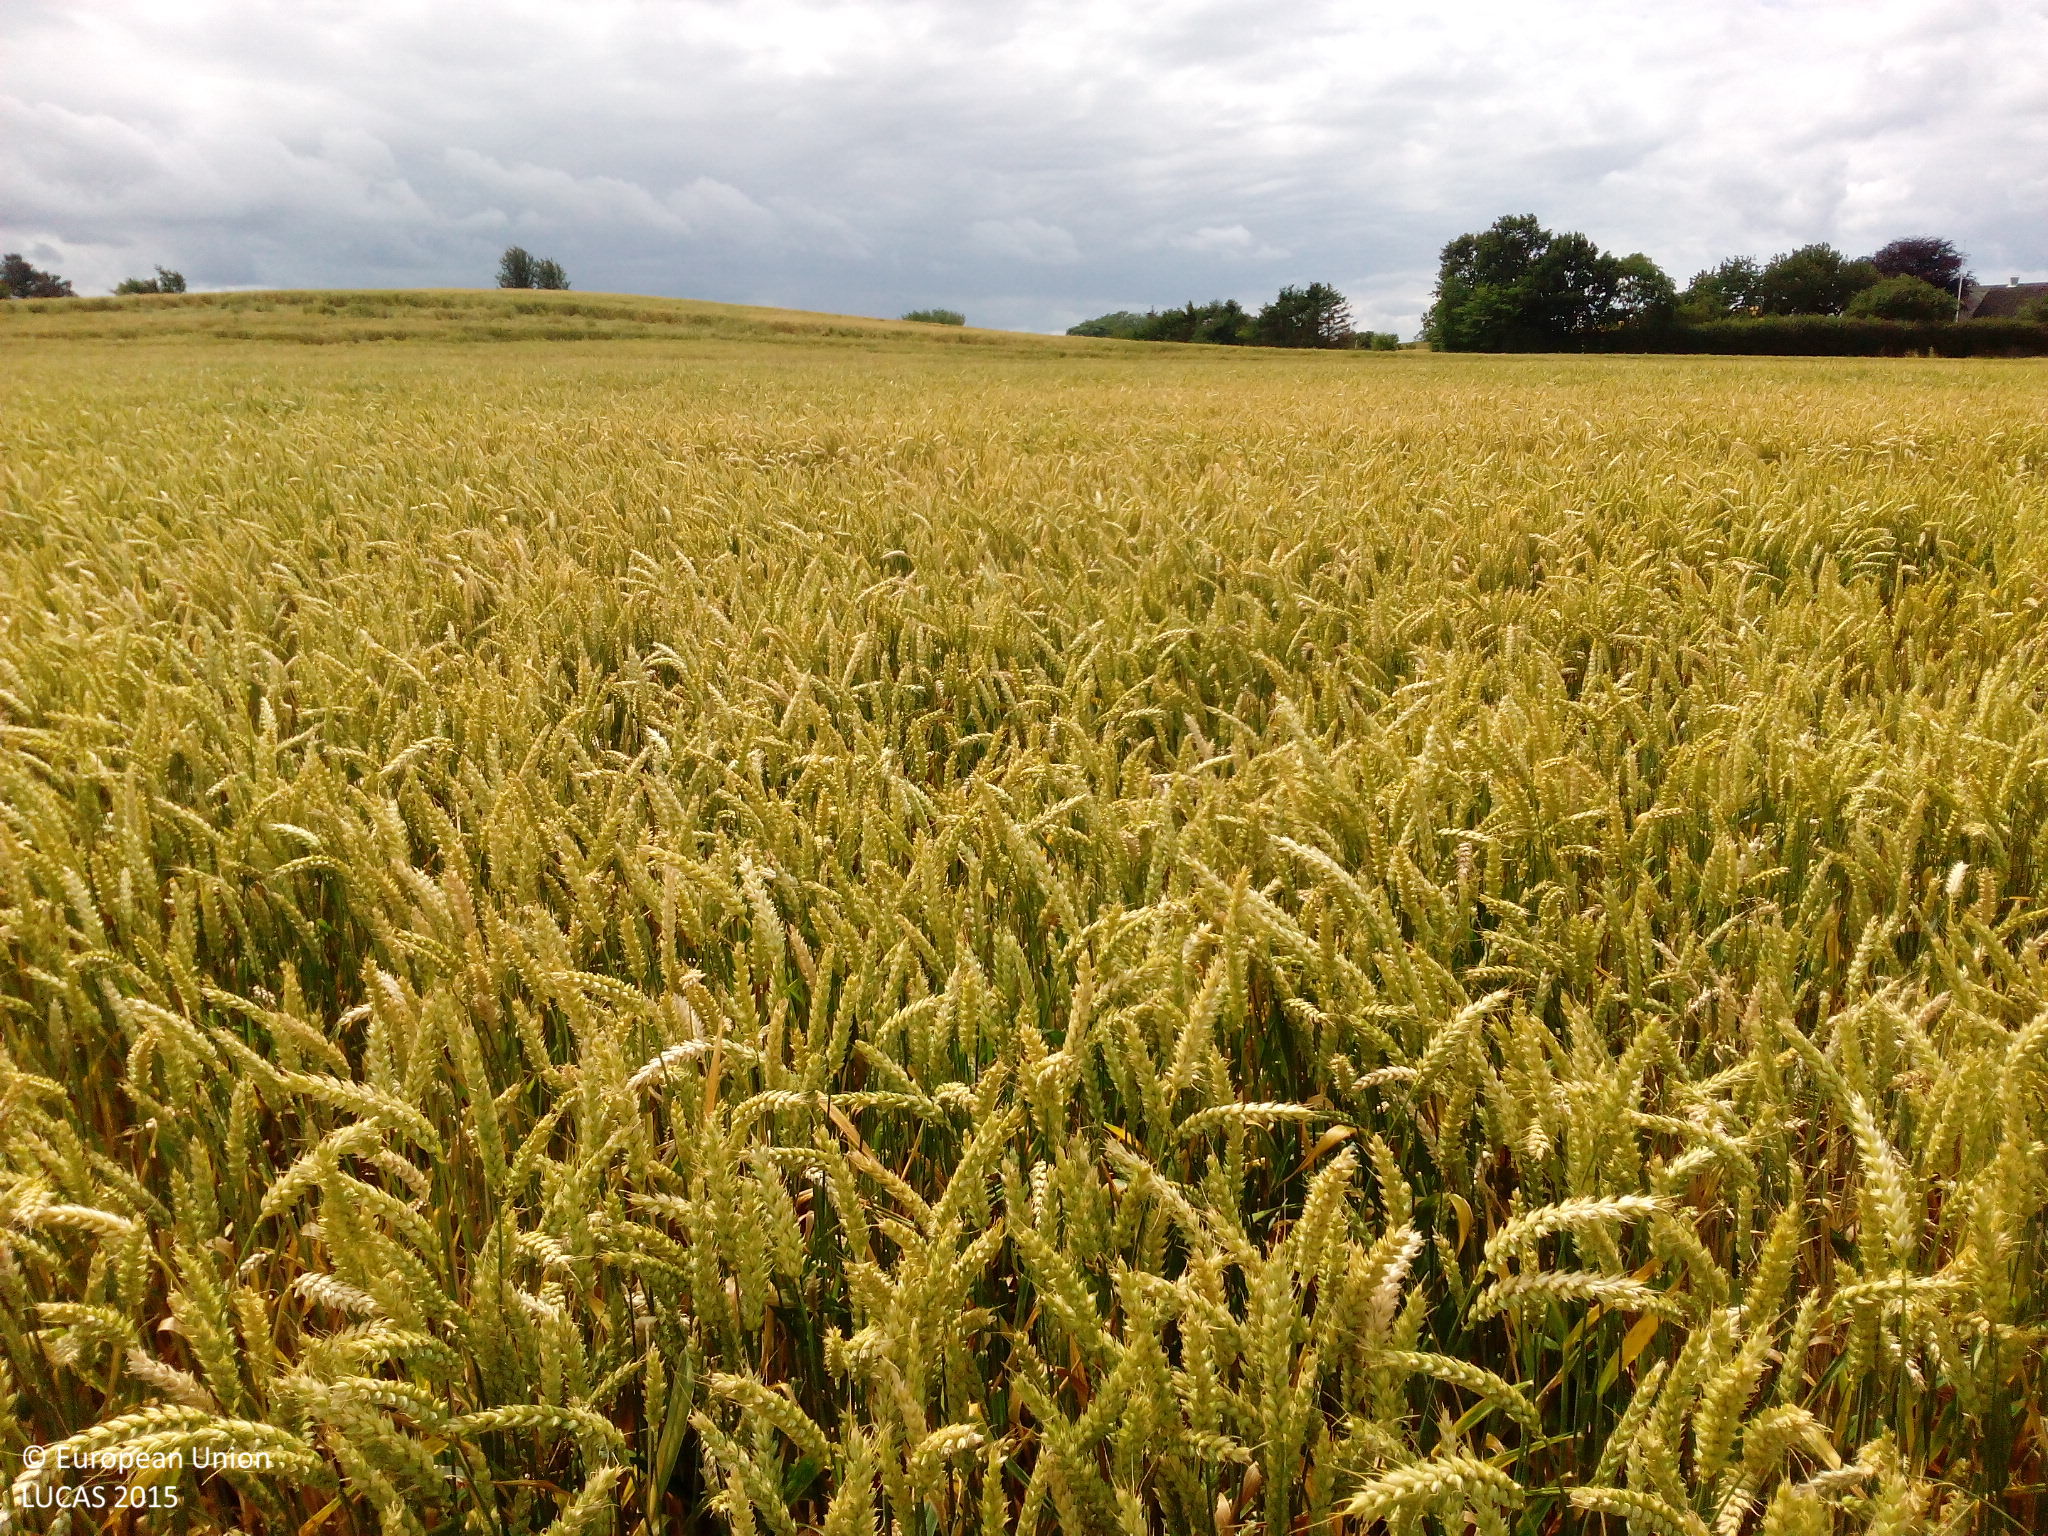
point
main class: Cropland
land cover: Common wheat
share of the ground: > 75 %
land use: Agriculture (excluding fallow land and kitchen gardens)
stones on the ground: < 10 %
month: July
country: DK
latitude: 55.9897
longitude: 12.1620
